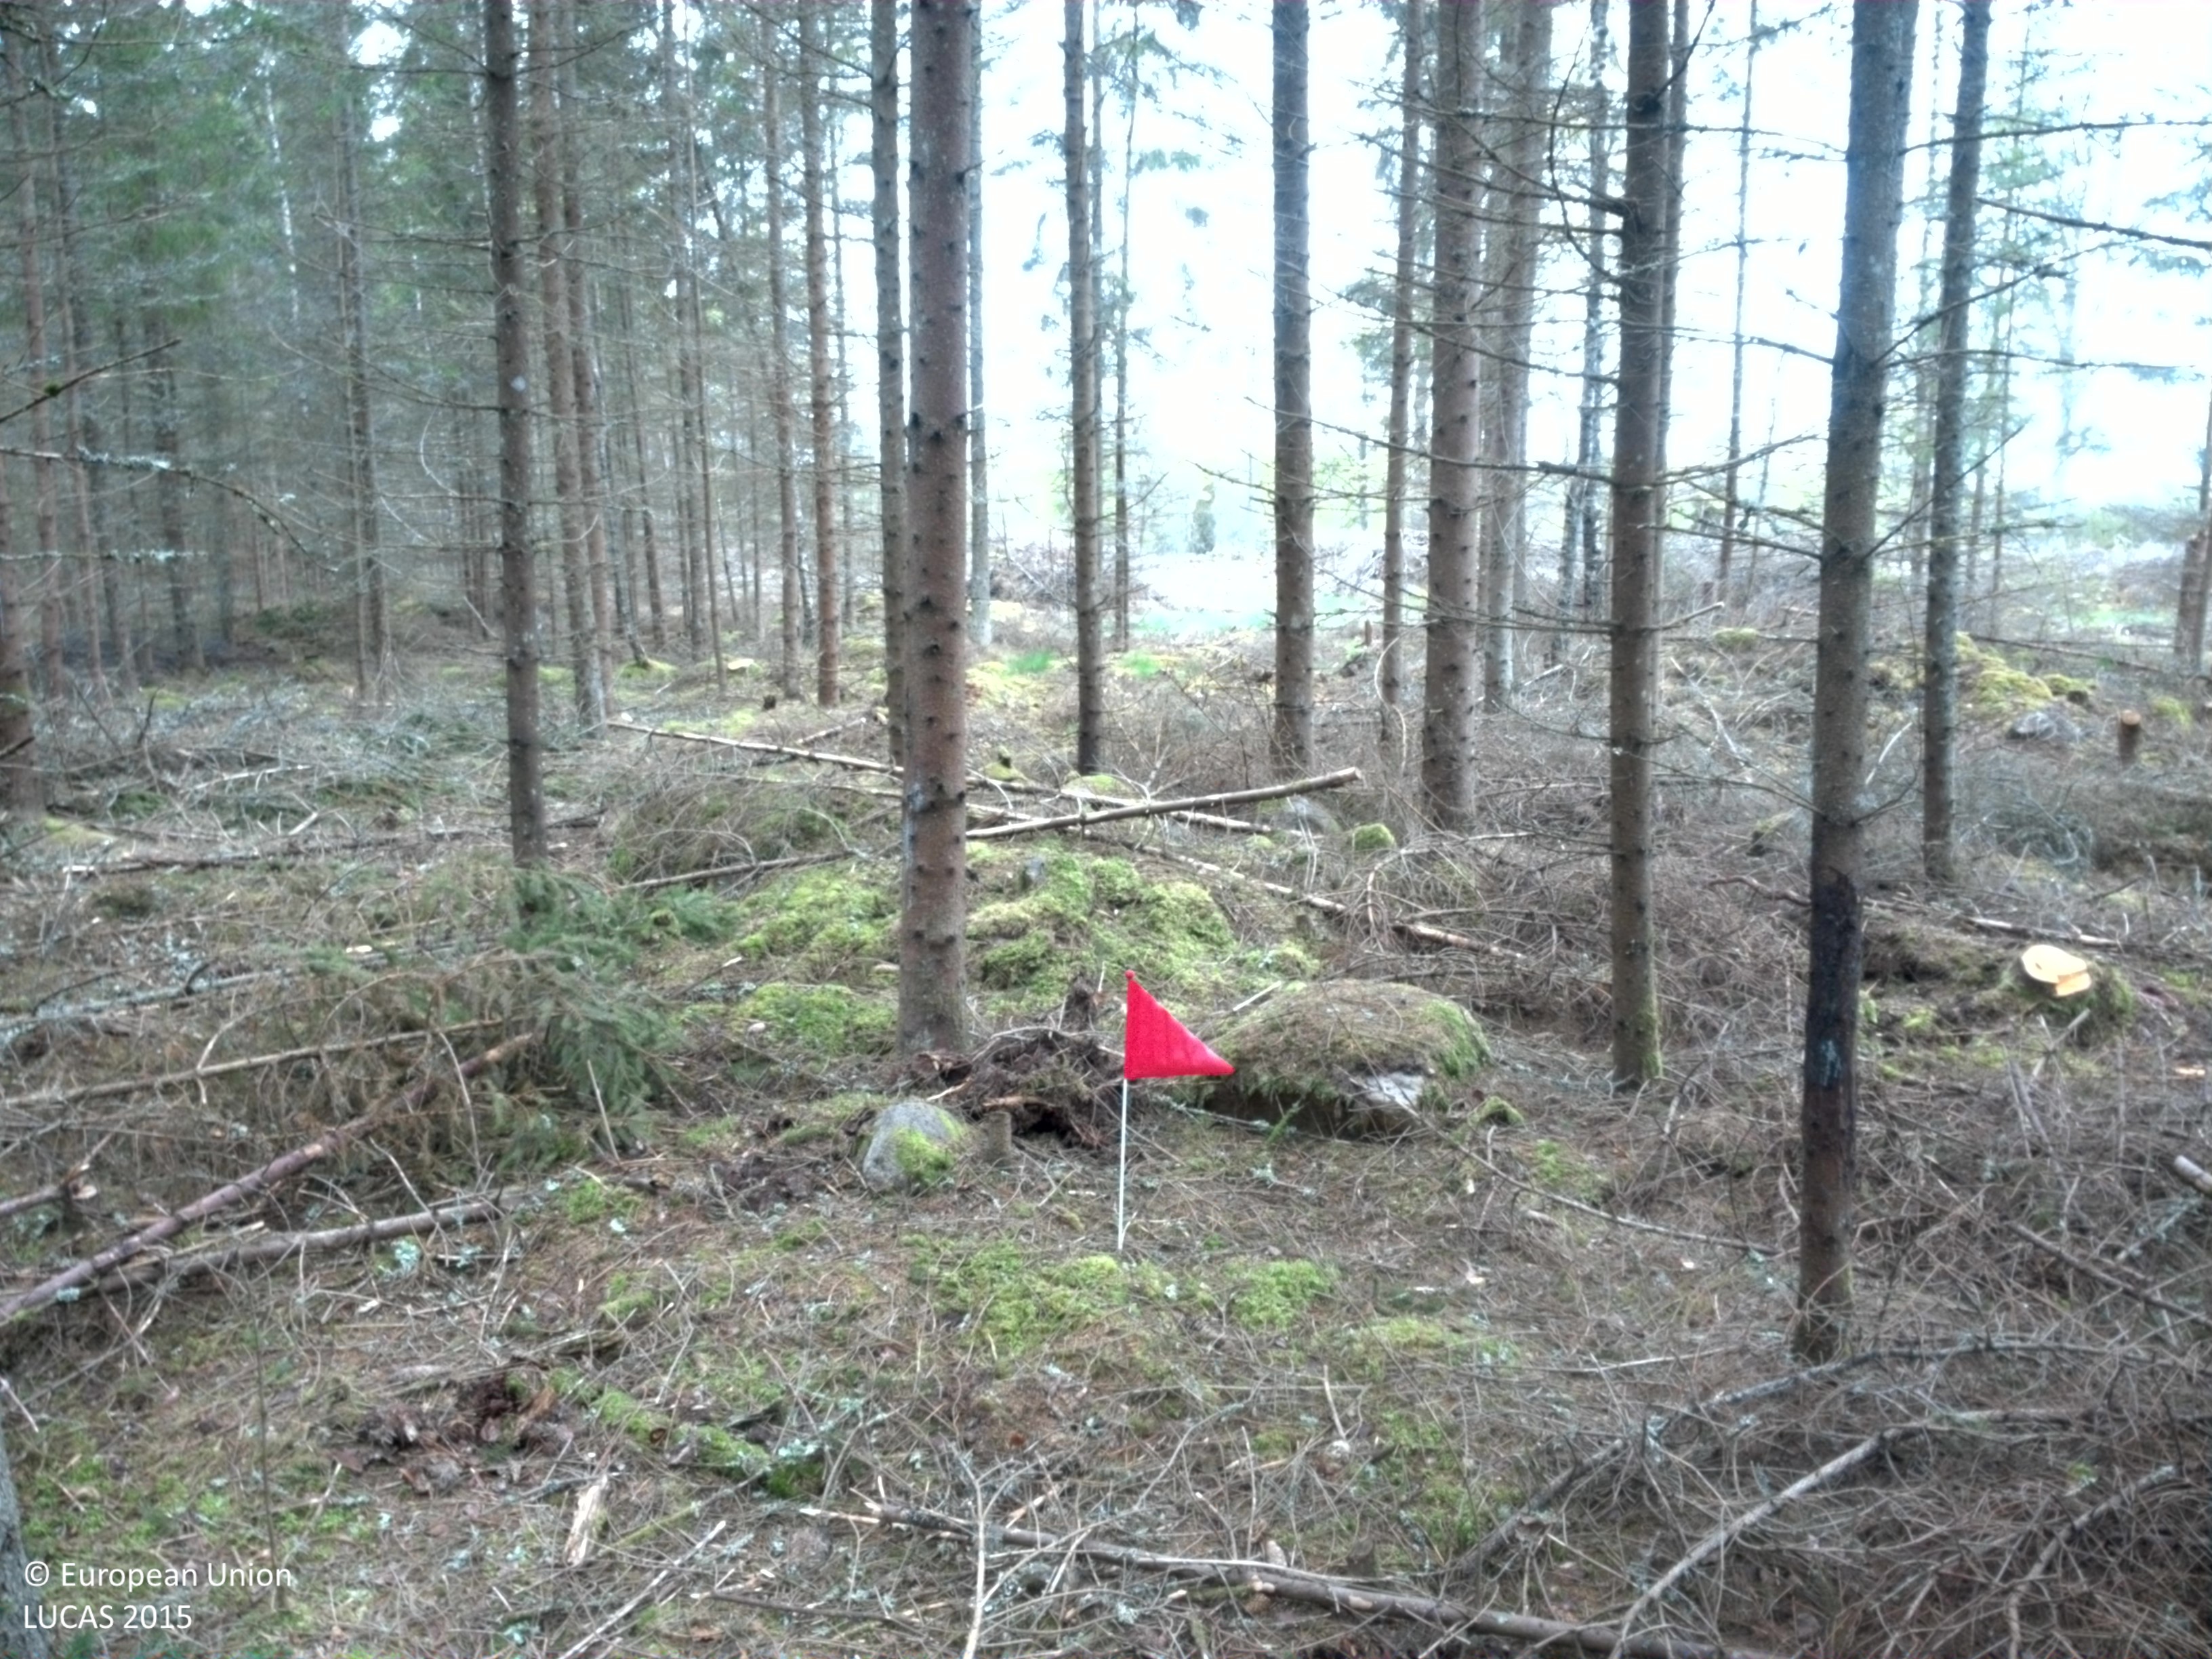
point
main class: Woodland
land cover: Spruce dominated coniferous woodland
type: boreal forest
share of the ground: > 75 %
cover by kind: coniferous forest trees 70 %, lichens and mosses 20 %, broadleaved forest trees 10 %
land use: Forestry
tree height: > 5 m
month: May
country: SE
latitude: 56.6103
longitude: 15.0650
